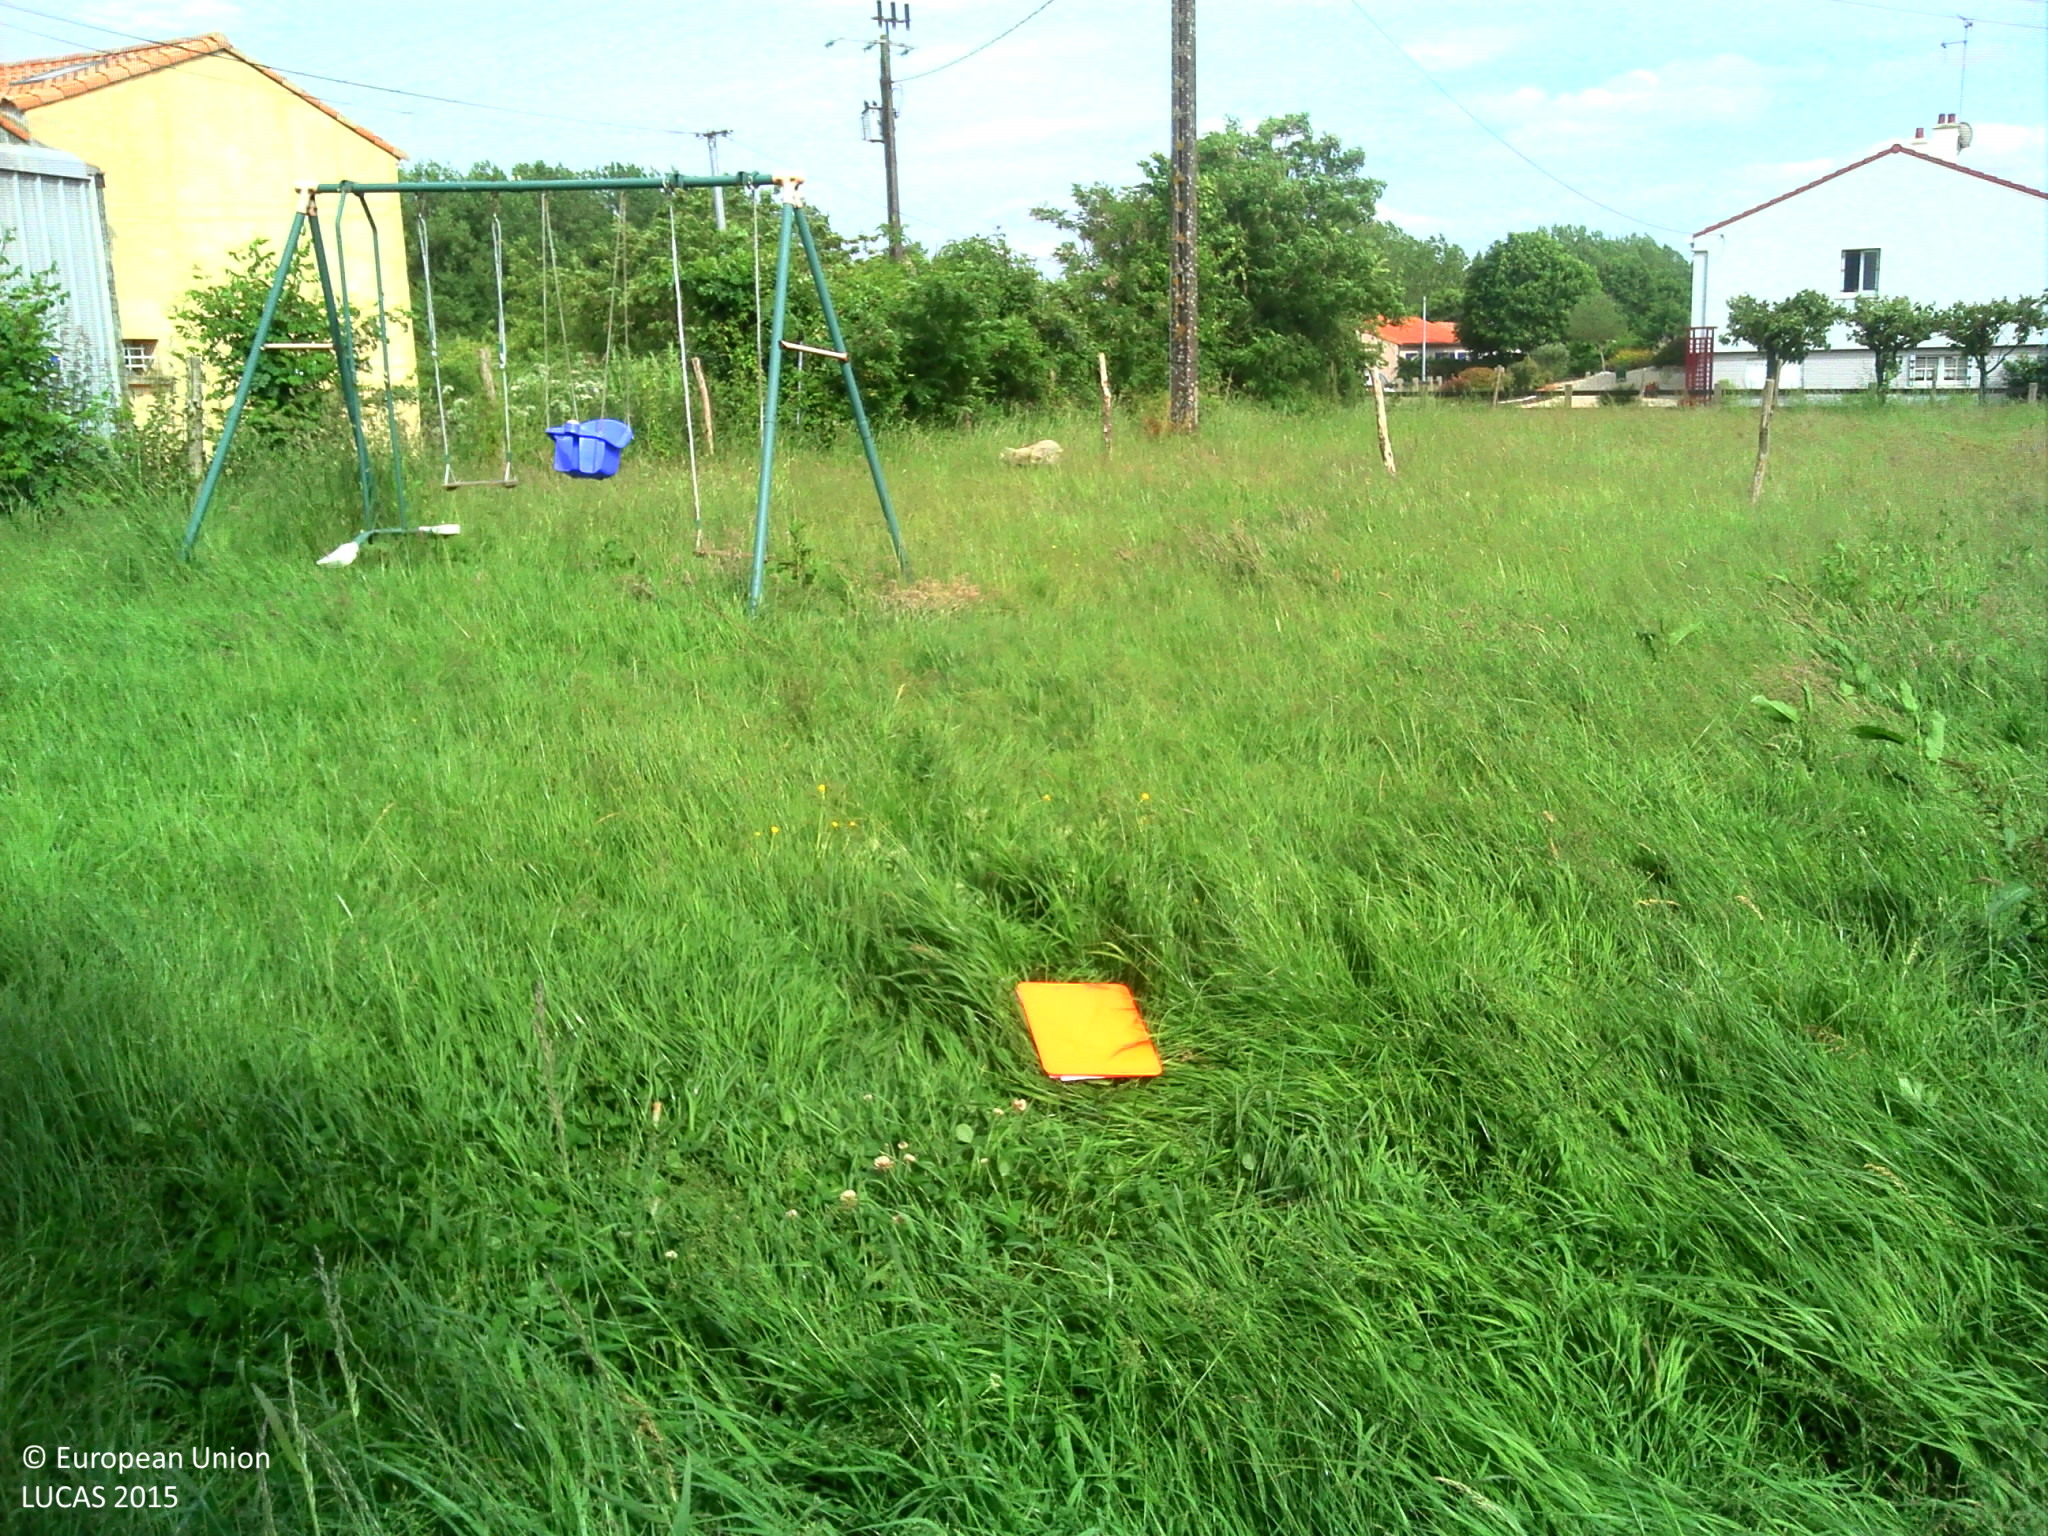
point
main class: Grassland
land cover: Grassland with sparse tree/shrub cover
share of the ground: > 75 %
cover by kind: herbaceous plants 90 %, broadleaved forest trees 5 %, shrubs 5 %
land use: Residential
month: May
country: FR
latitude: 46.9967
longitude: -1.2013
